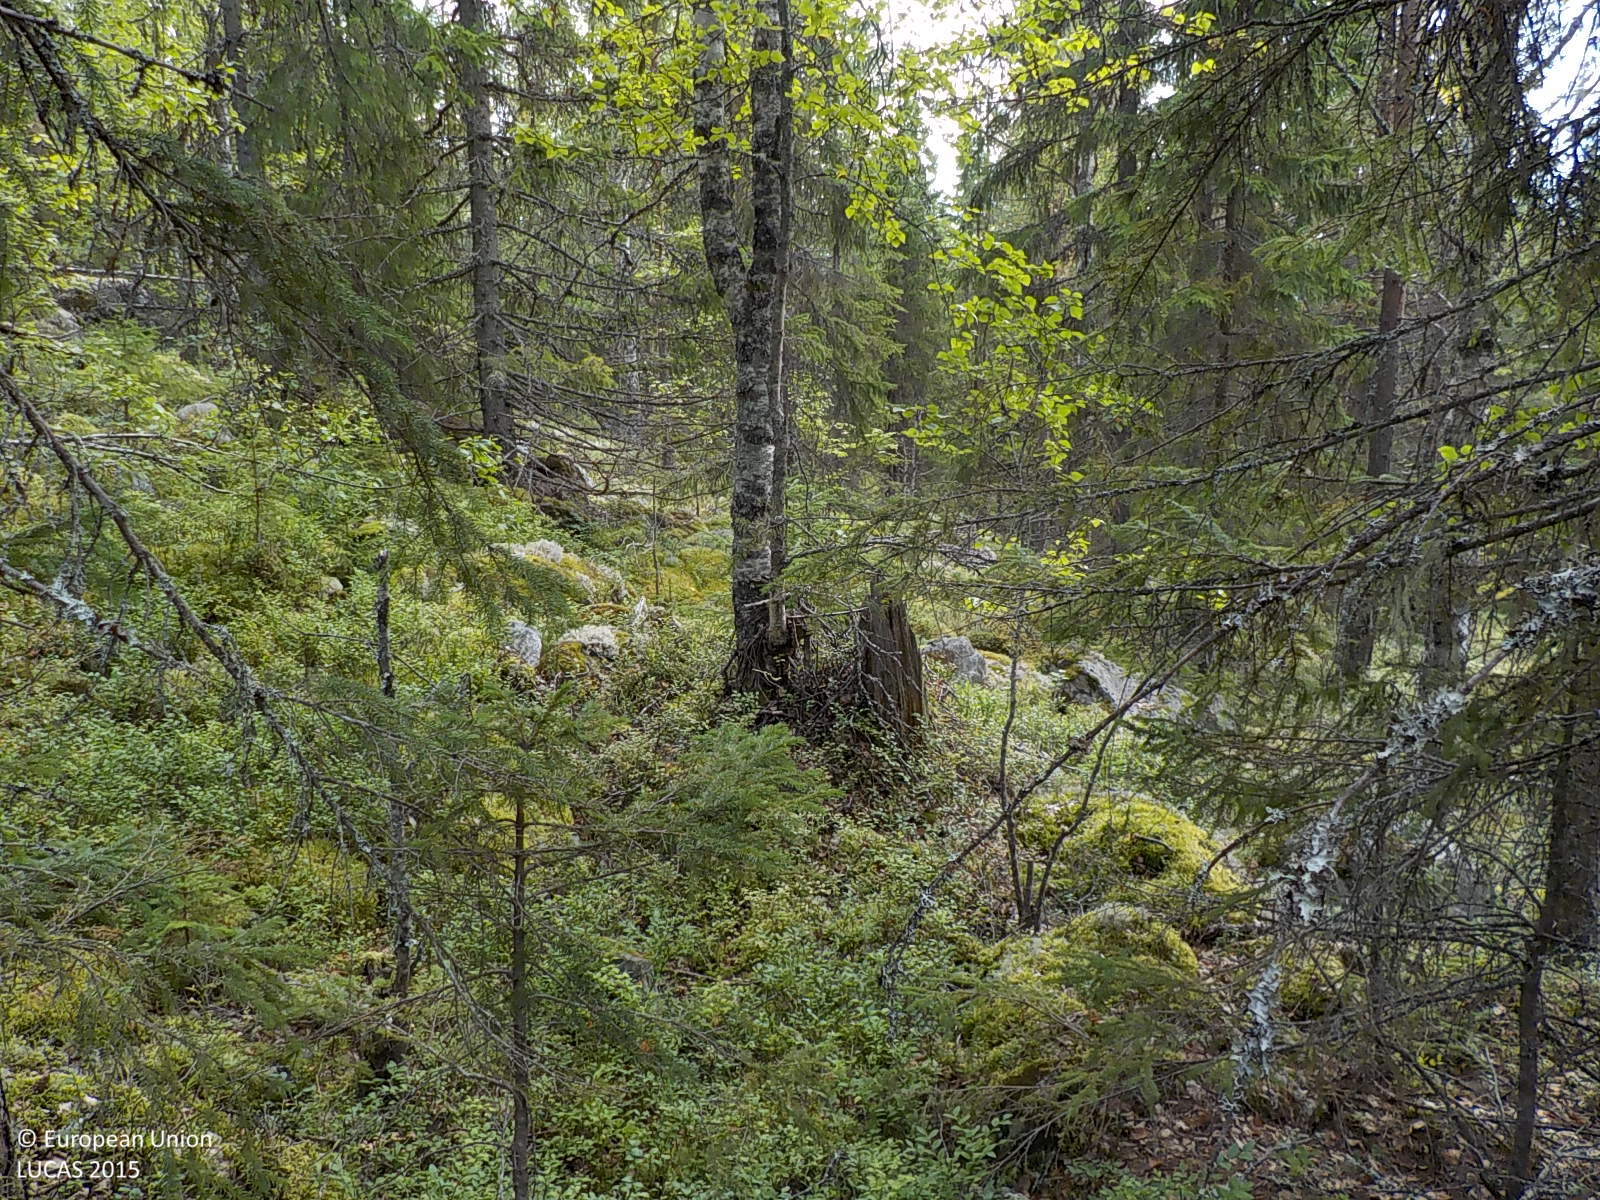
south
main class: Woodland
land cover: Pine dominated coniferous woodland
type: boreal forest
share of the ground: > 75 %
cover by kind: coniferous forest trees 80 %, shrubs 10 %, broadleaved forest trees 5 %, lichens and mosses 5 %
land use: Forestry
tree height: > 5 m
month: September
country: SE
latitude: 63.2443
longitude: 17.8008
